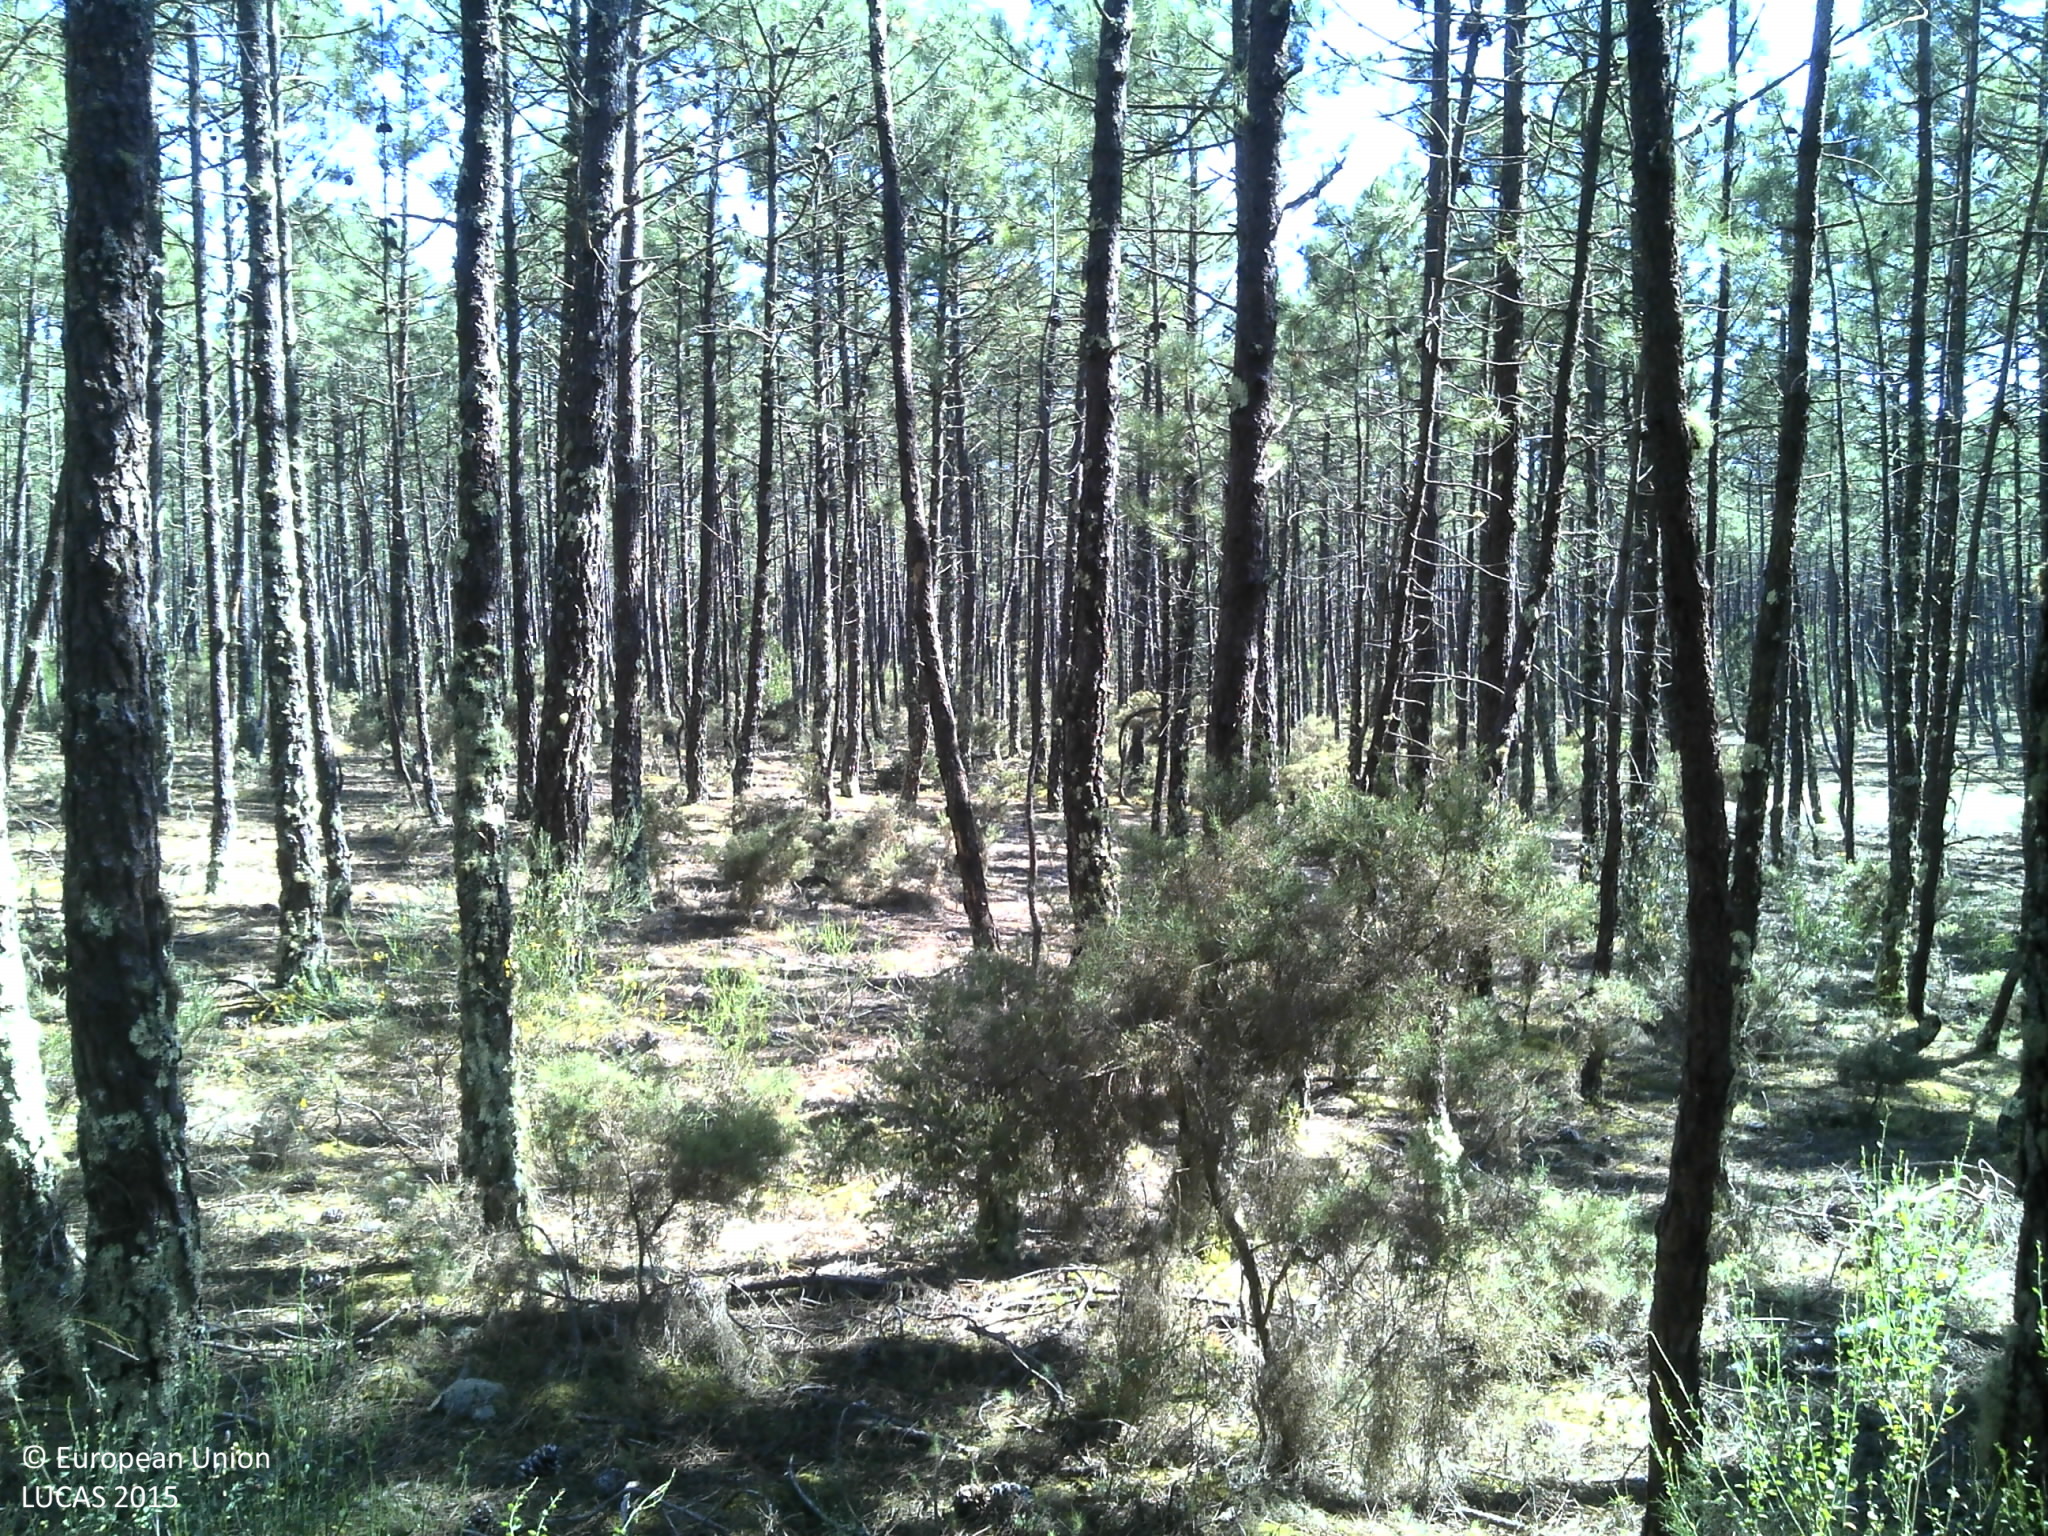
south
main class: Woodland
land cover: Pine dominated coniferous woodland
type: coniferous forest of the mediterranean region
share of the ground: 50 - 75 %
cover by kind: coniferous forest trees 75 %, unconsolidated bare surface 15 %, shrubs 10 %
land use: Forestry
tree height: > 5 m
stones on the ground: < 10 %
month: May
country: PT
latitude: 40.5742
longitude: -8.7274
